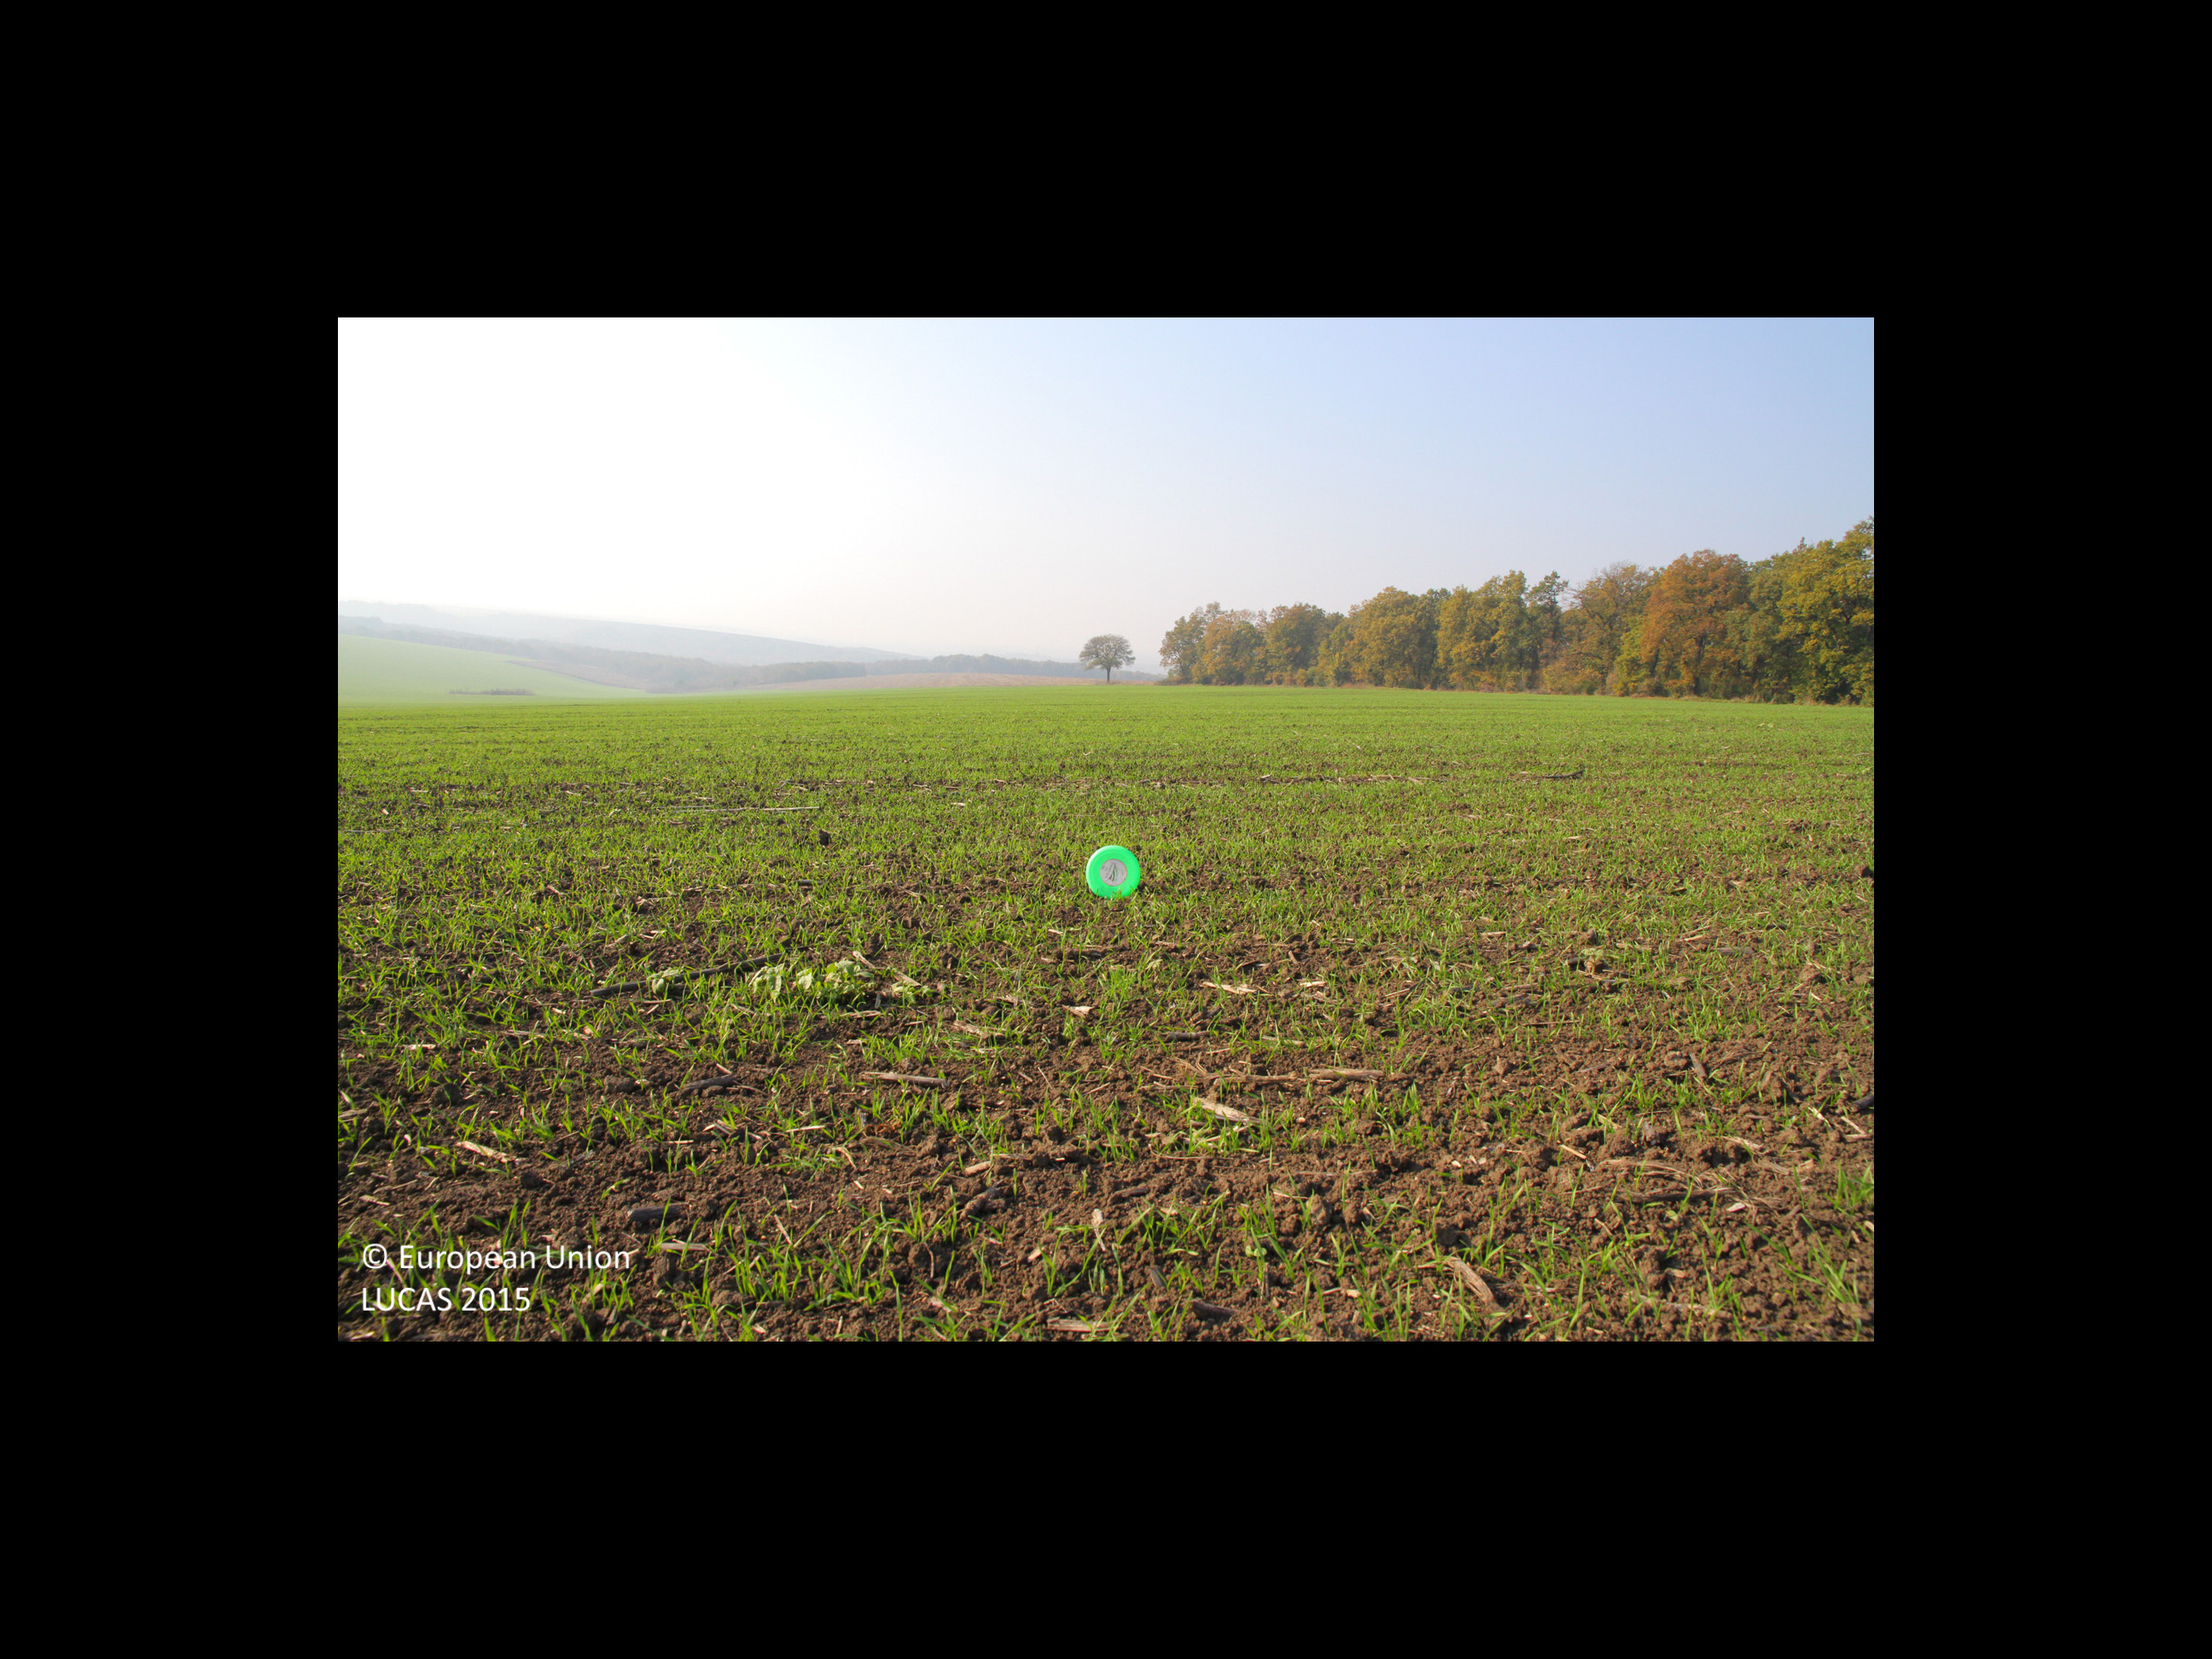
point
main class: Cropland
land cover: Sunflower
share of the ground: < 10 %
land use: Agriculture (excluding fallow land and kitchen gardens)
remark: Harvested field
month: November
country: BG
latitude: 43.7810
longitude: 26.4457
